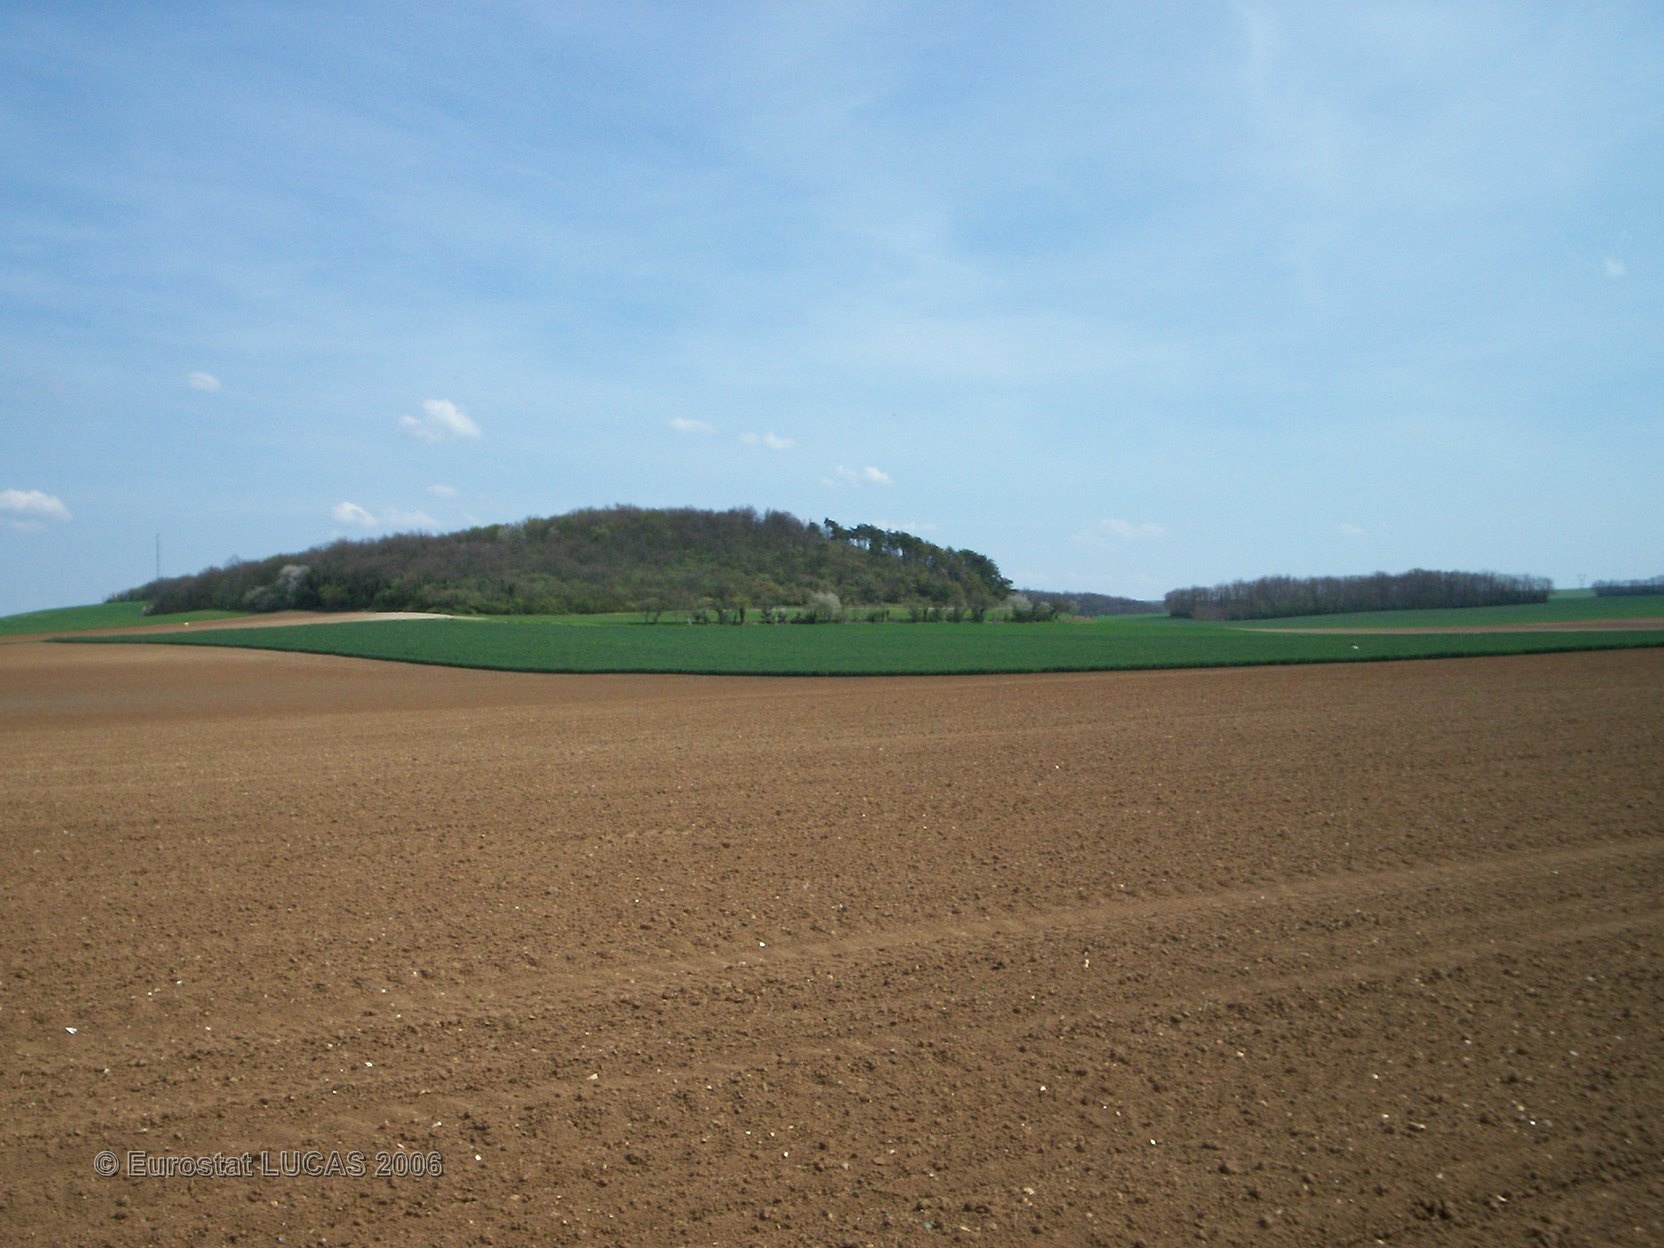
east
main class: Cropland
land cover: Sugar beet
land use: Agriculture (excluding fallow land and kitchen gardens)
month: April
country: FR
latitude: 48.3579
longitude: 2.9334
